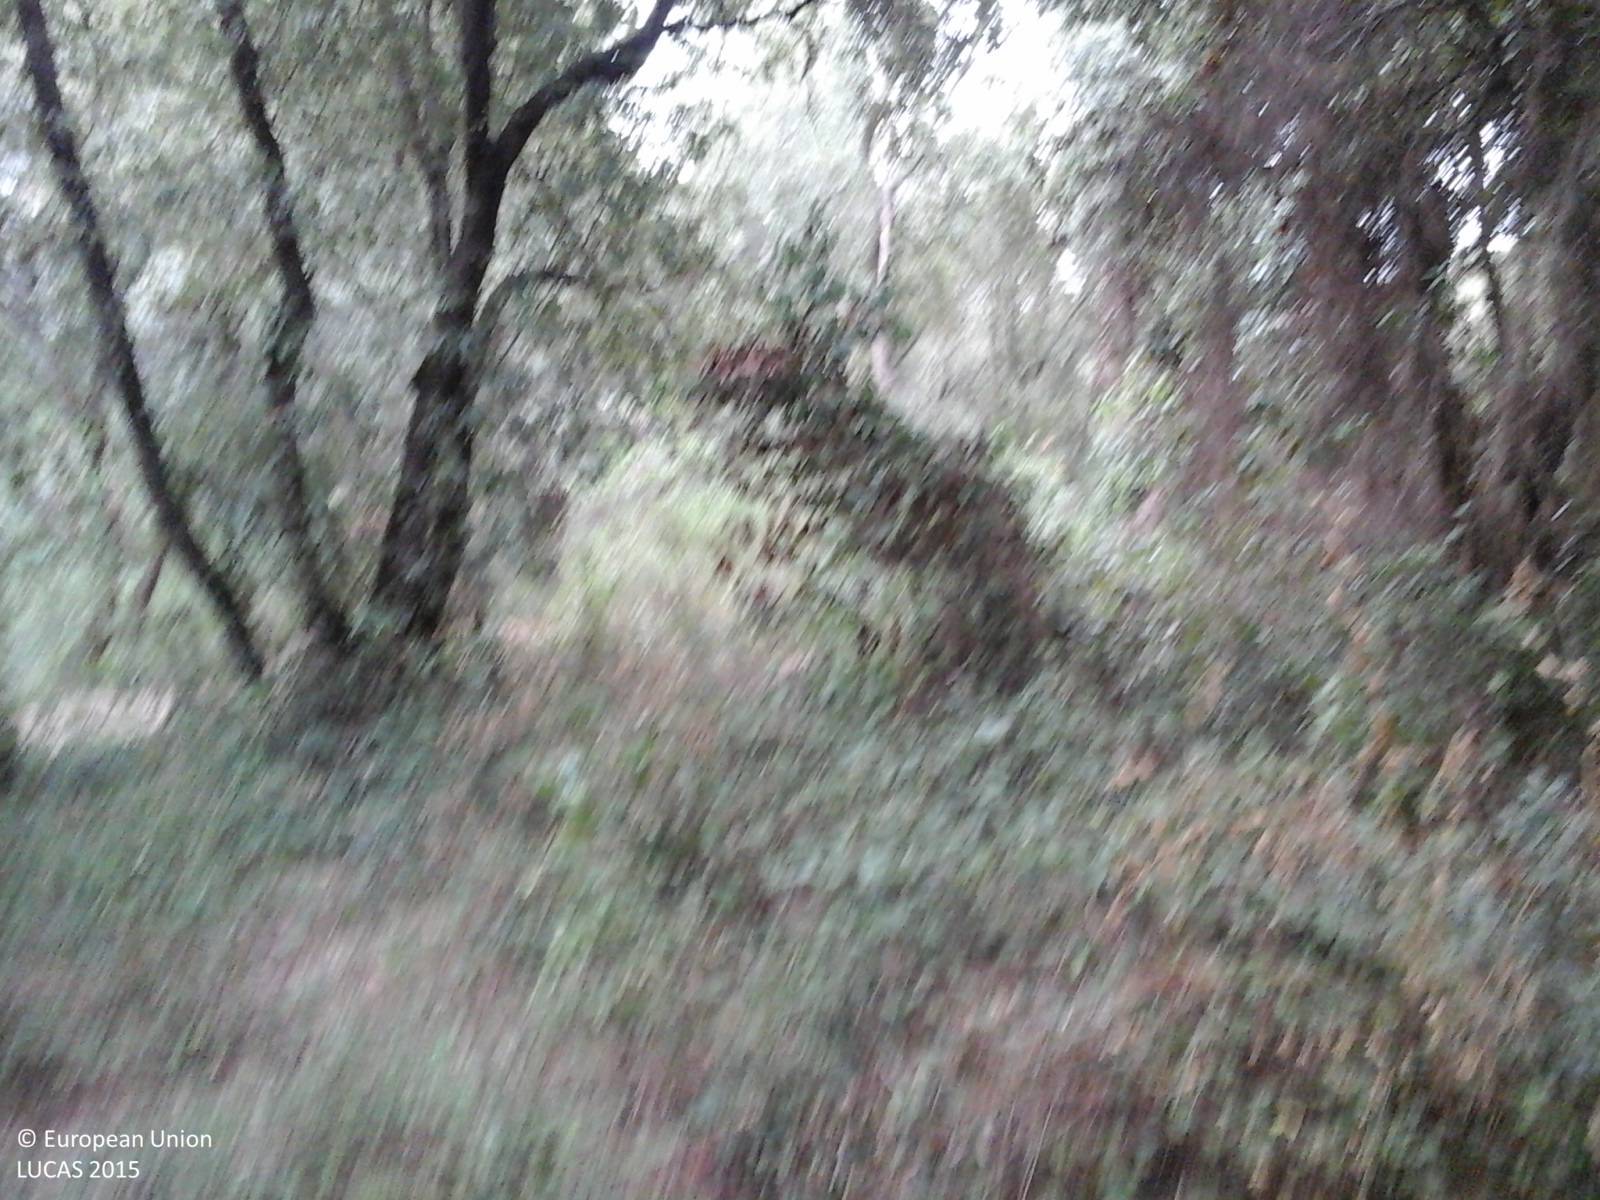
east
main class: Woodland
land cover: Pine dominated mixed woodland
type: coniferous forest of the mediterranean region
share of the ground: > 75 %
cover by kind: coniferous forest trees 65 %, broadleaved forest trees 25 %, shrubs 10 %
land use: Amenities, museums, leisure
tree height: > 5 m
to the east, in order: Pine dominated mixed woodland; Pine dominated coniferous woodland; Tracks; Pine dominated coniferous woodland; Tracks; Pine dominated coniferous woodland
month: July
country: IT
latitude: 41.7239
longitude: 12.3110
